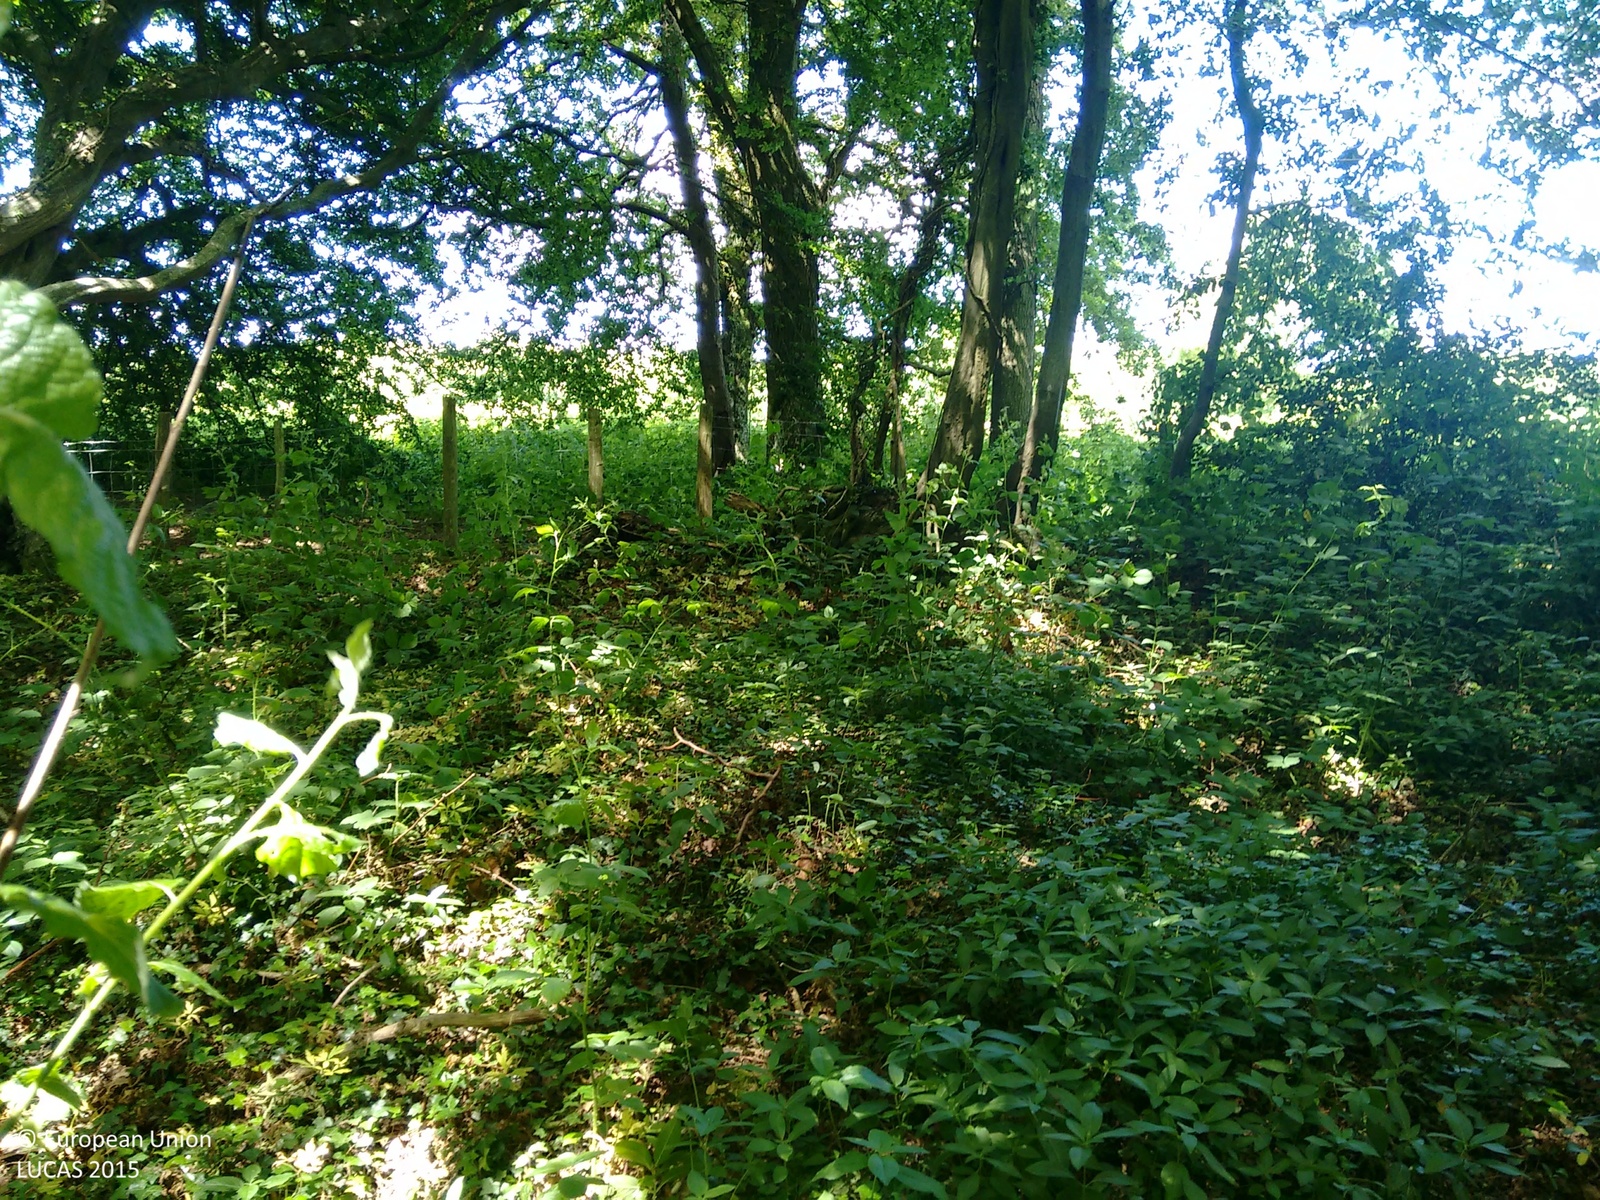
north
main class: Woodland
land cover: Broadleaved woodland
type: mesophytic deciduous forest
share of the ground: > 75 %
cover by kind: broadleaved forest trees 100 %
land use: Semi-natural and natural areas not in use
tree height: > 5 m
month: June
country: GB
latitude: 50.9376
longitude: 0.6238
